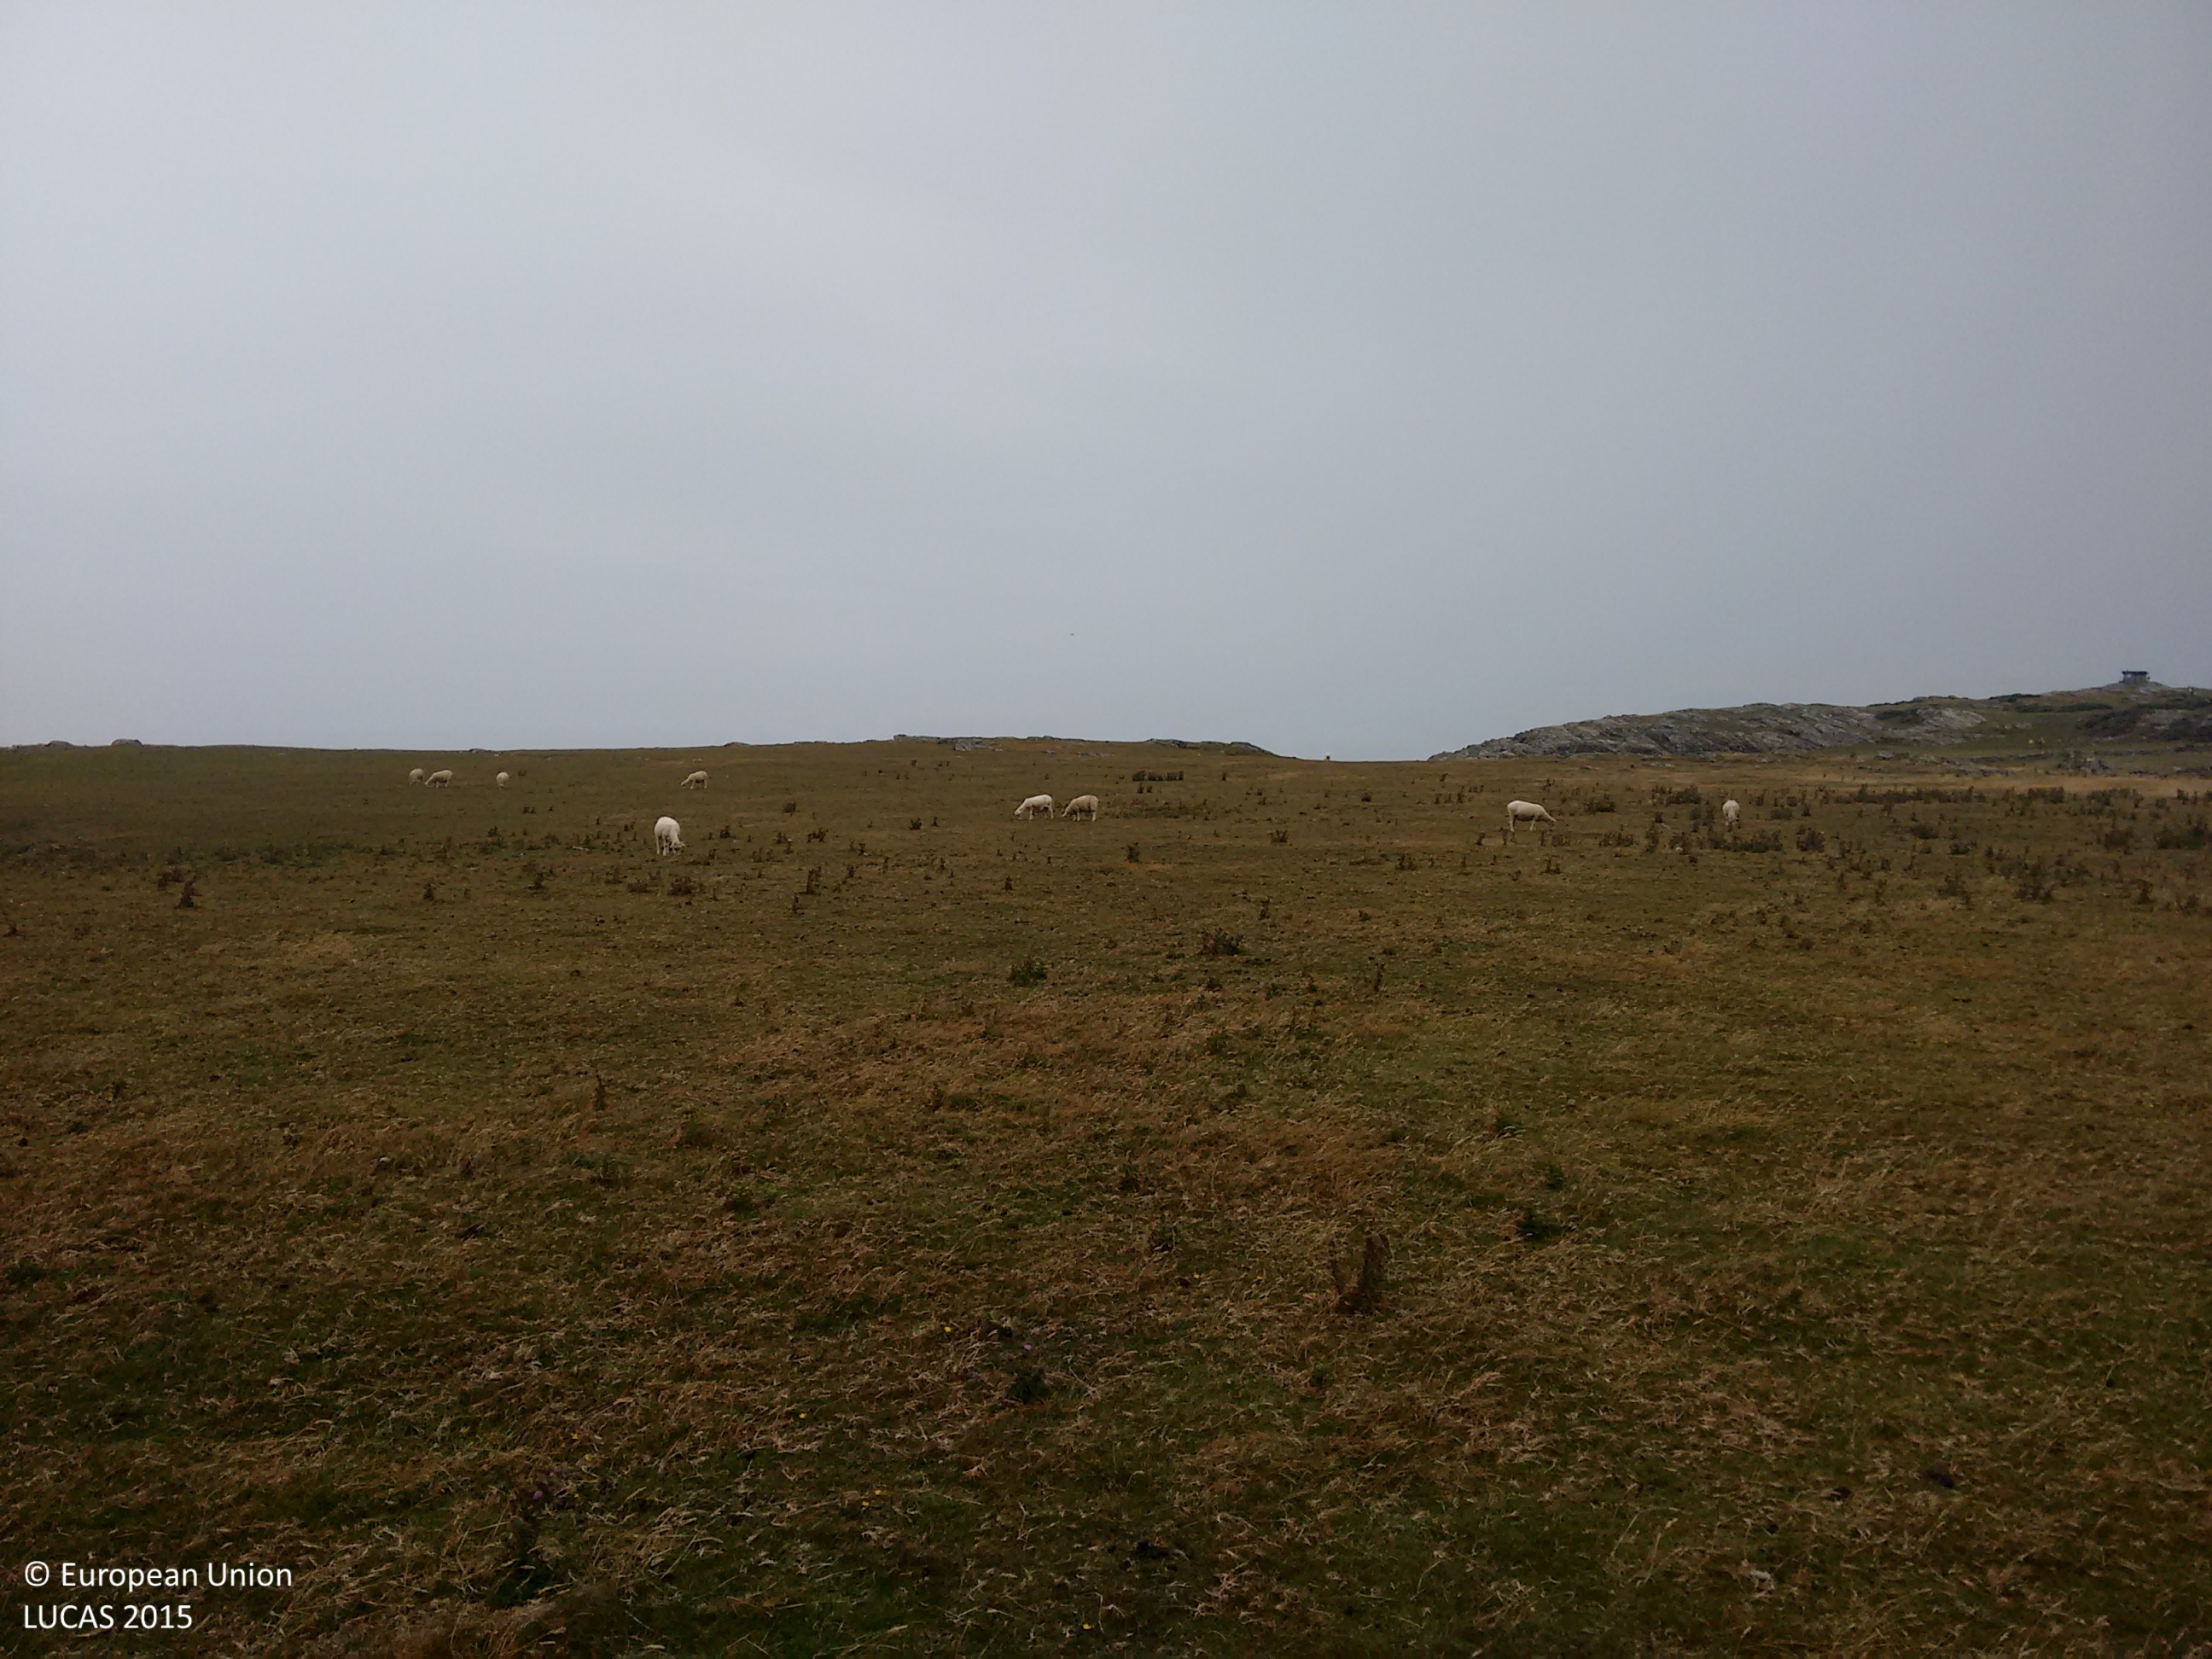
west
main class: Grassland
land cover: Grassland without tree/shrub cover
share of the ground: > 75 %
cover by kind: herbaceous plants 100 %
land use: Agriculture (excluding fallow land and kitchen gardens)
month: August
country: GB
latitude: 53.2423
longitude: -4.5974
